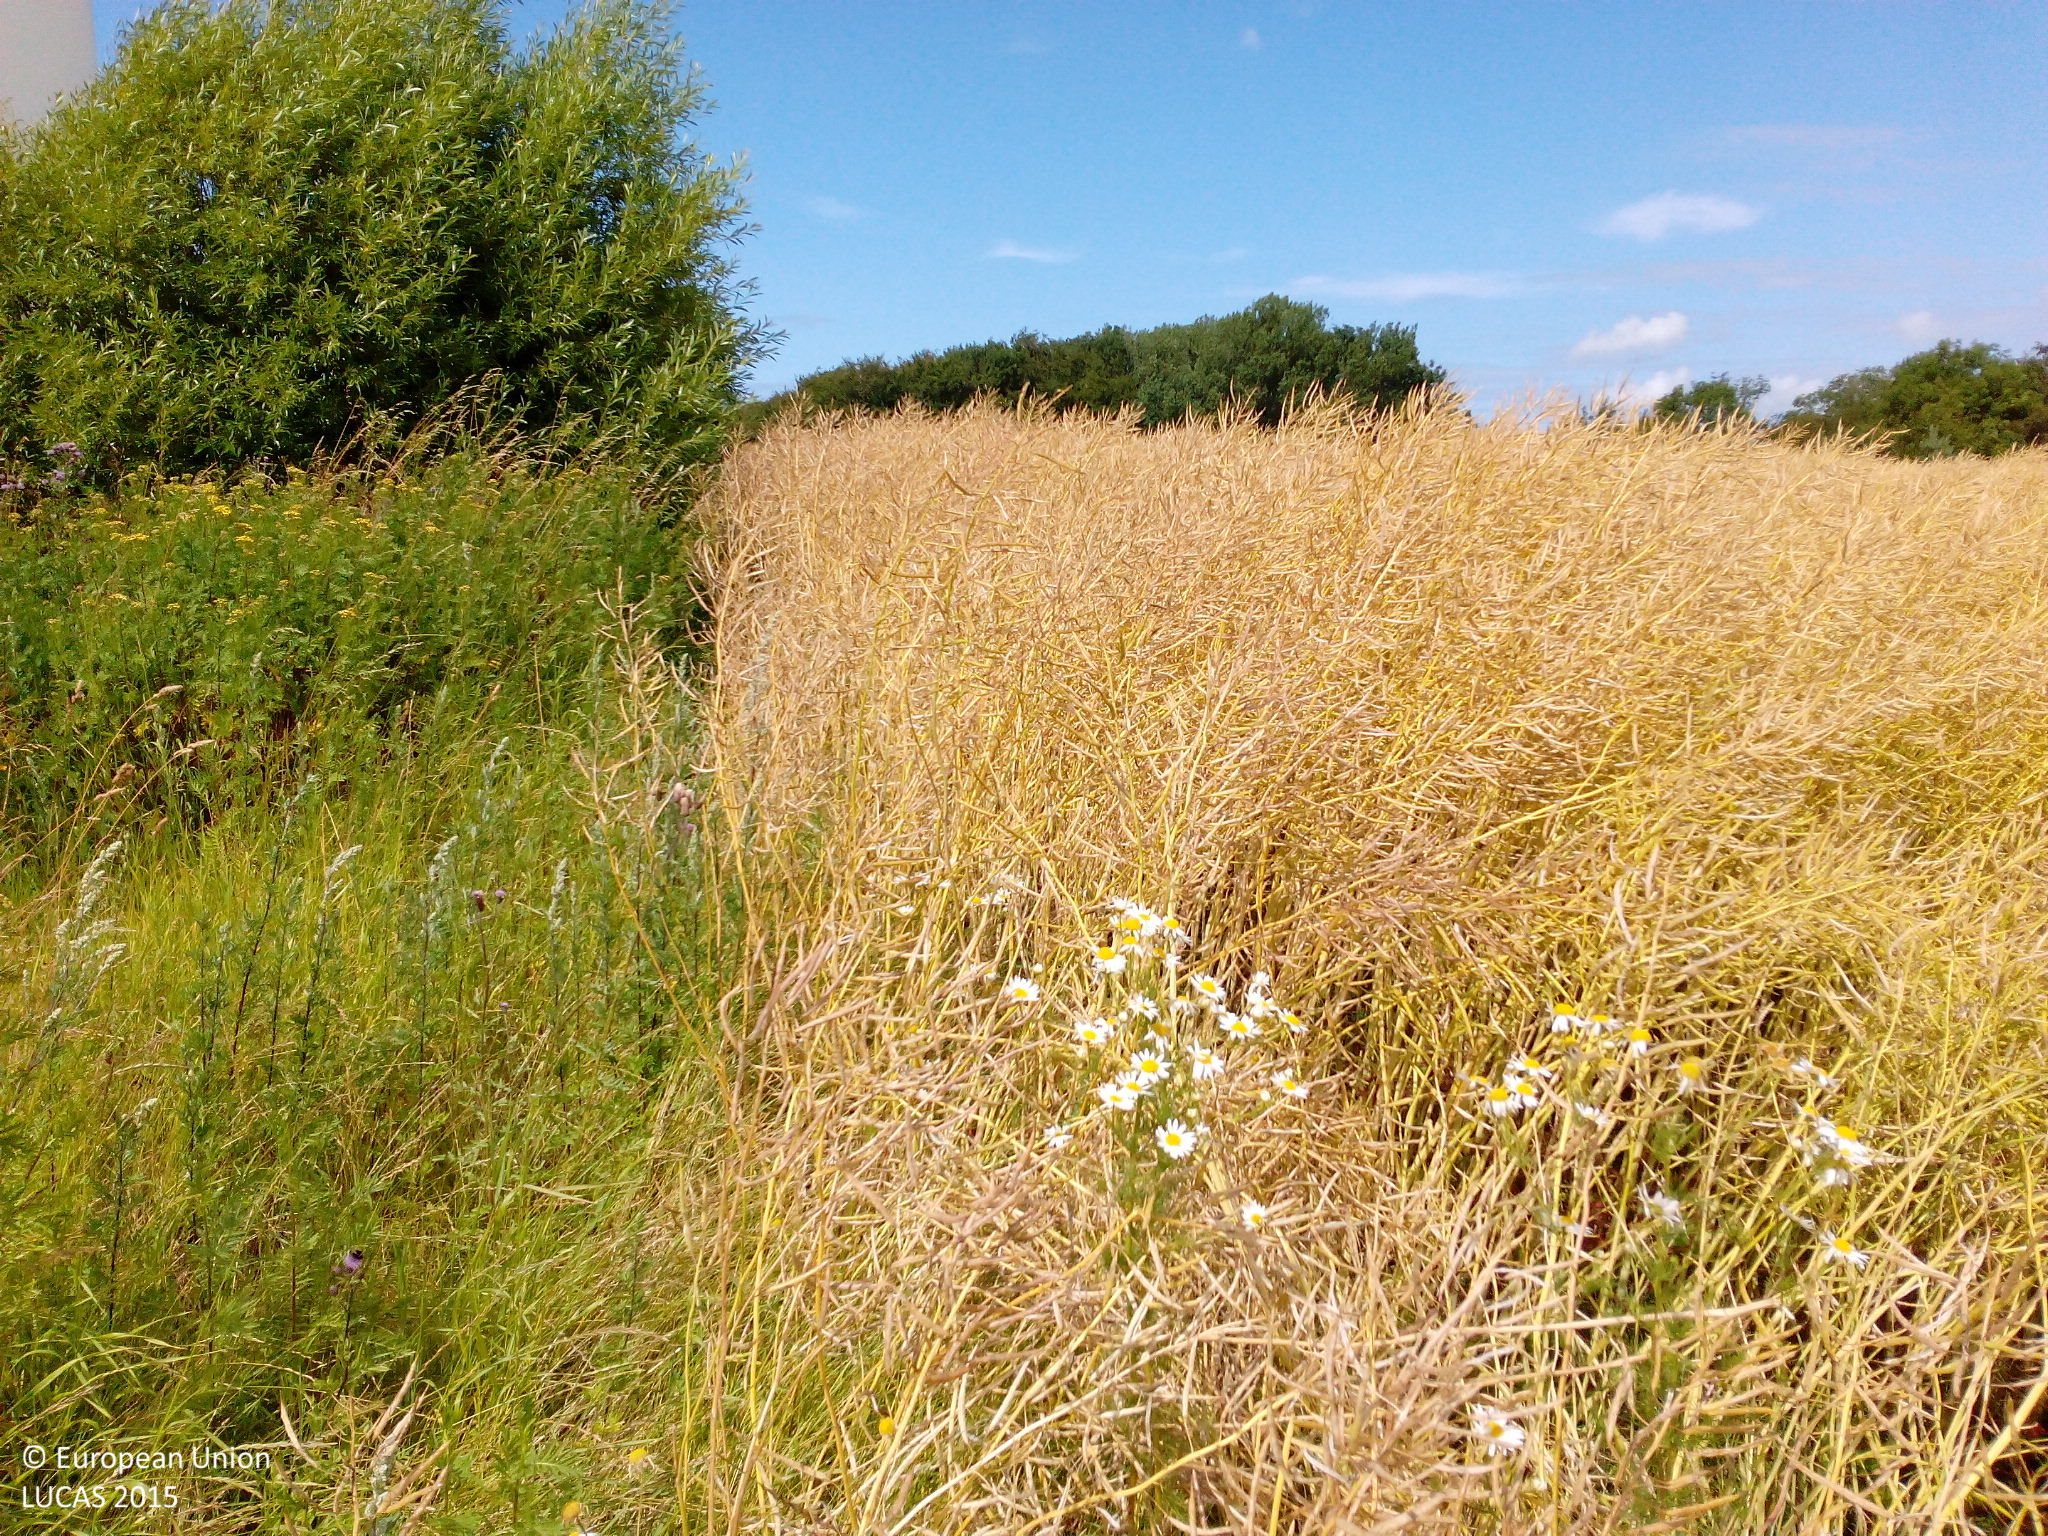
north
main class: Cropland
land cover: Rape and turnip rape
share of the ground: > 75 %
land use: Agriculture (excluding fallow land and kitchen gardens)
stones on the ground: < 10 %
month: July
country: DK
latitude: 55.7308
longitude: 11.3841
